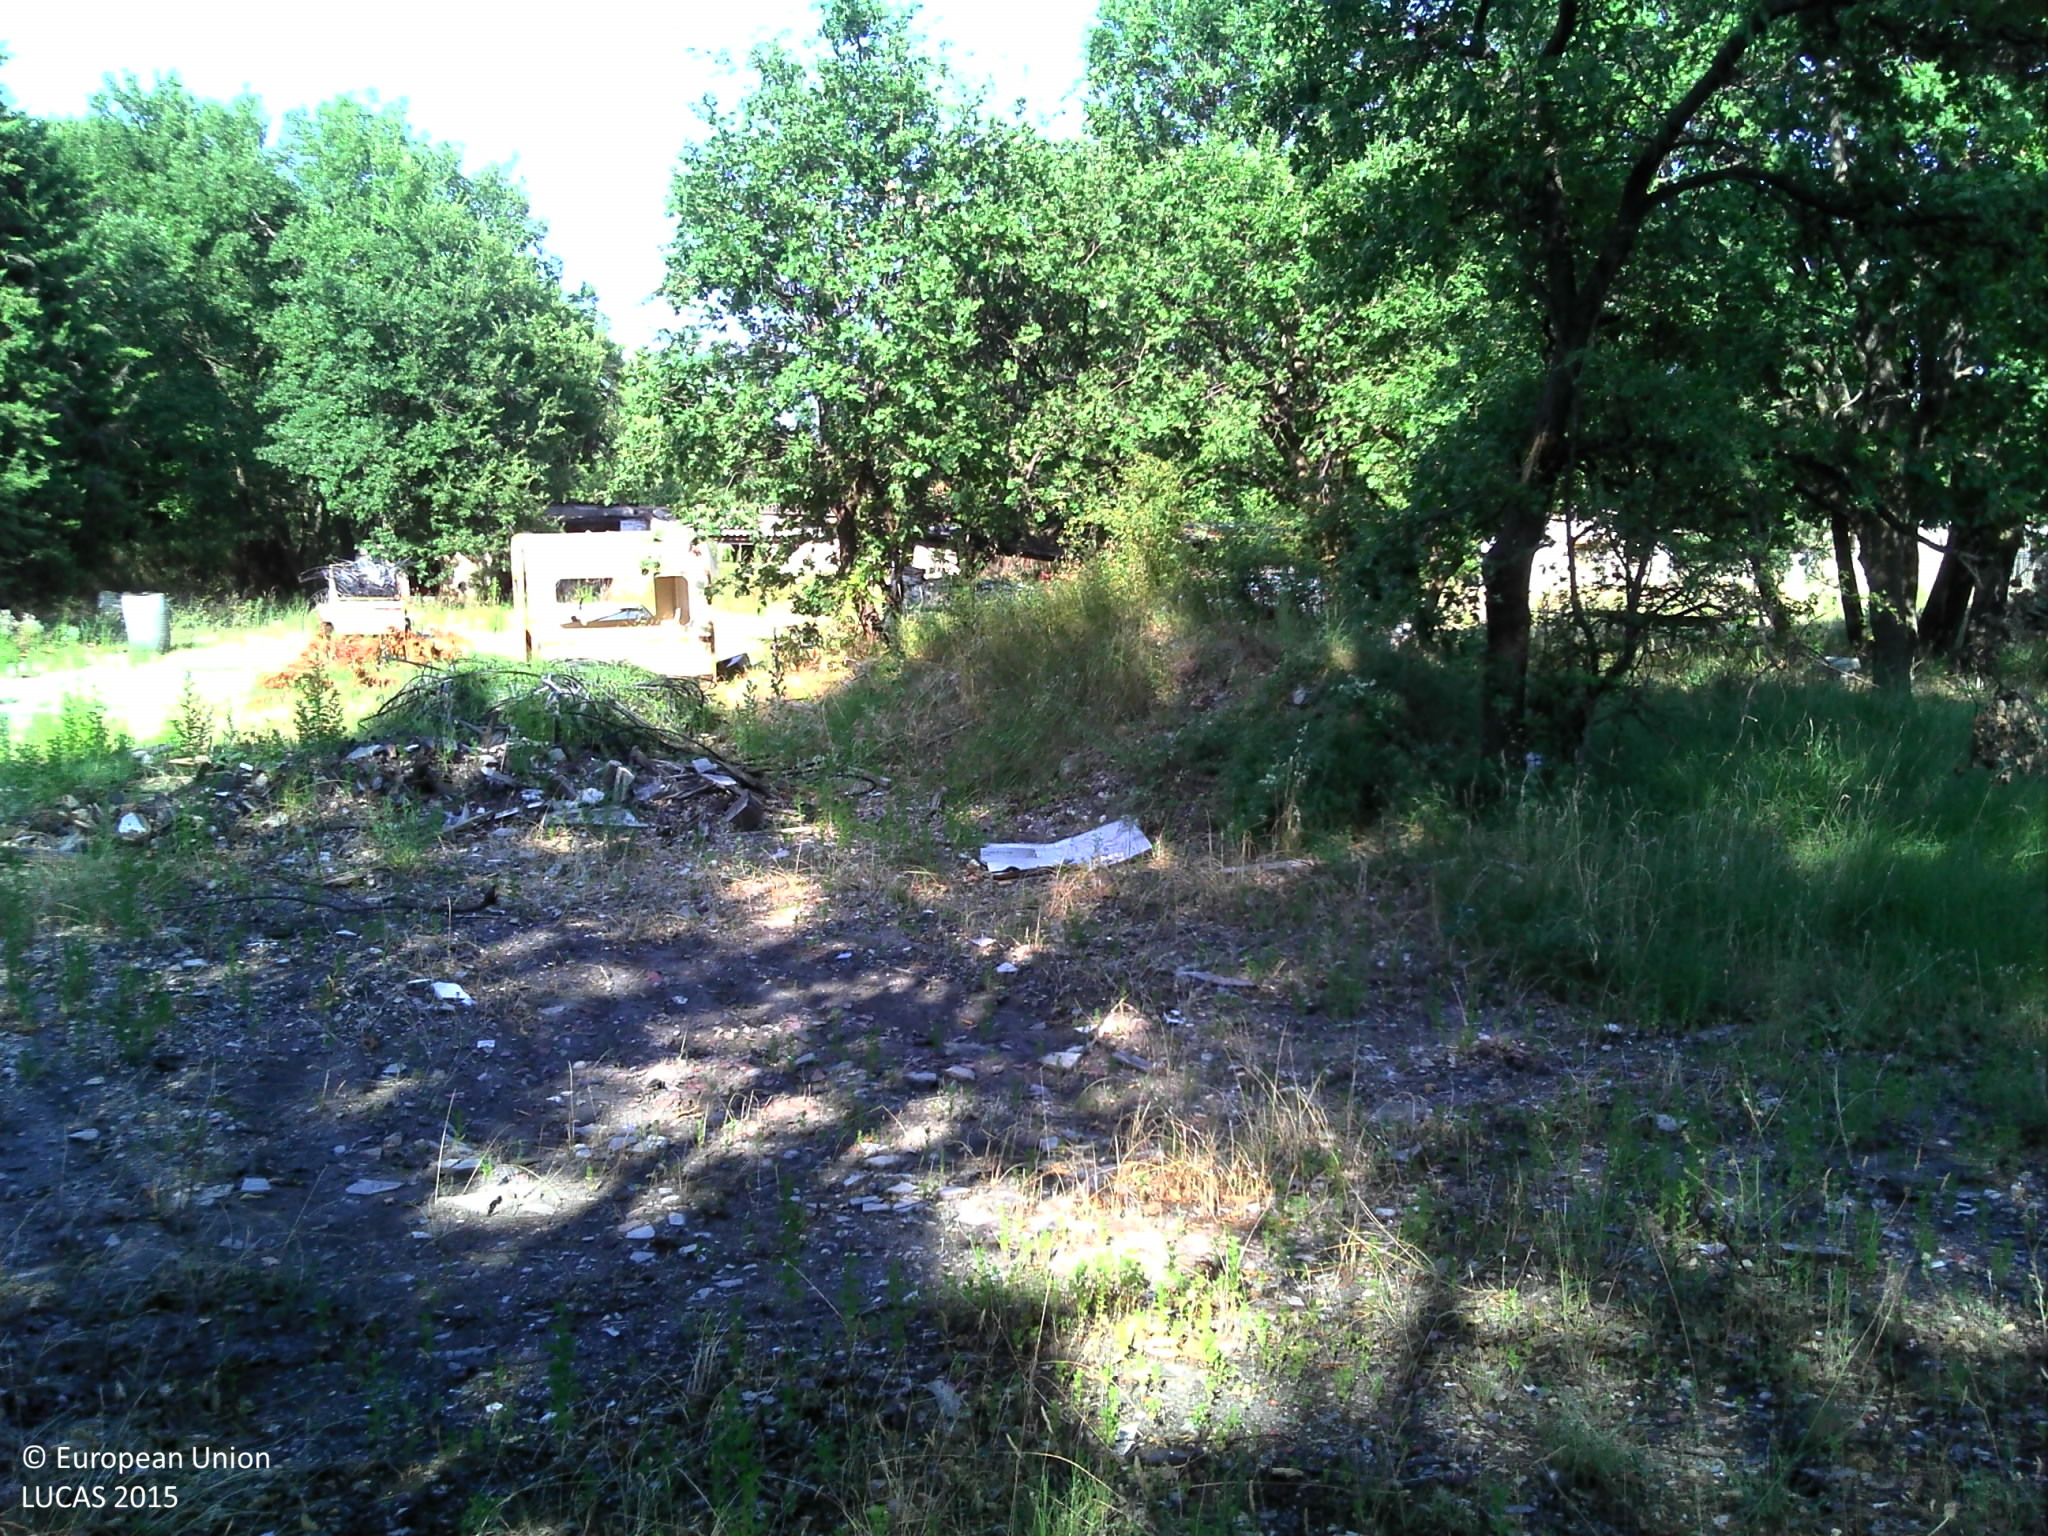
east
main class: Woodland
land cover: Broadleaved woodland
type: thermophilous deciduous forest
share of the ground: > 75 %
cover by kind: broadleaved forest trees 60 %, herbaceous plants 20 %, unconsolidated bare surface 10 %, coniferous forest trees 5 %, shrubs 5 %
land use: Forestry
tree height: > 5 m
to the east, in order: Broadleaved woodland; Other bare soil; Artificial constructions; Broadleaved woodland; Fences; Vineyards; Broadleaved woodland; Fences; Broadleaved woodland; Tracks; Broadleaved woodland; Fences; Electric lines; Paved roads, cycling and walking lanes; Grass margins; Fences; Cherry fruit
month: October
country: FR
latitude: 44.0903
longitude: 5.0997
